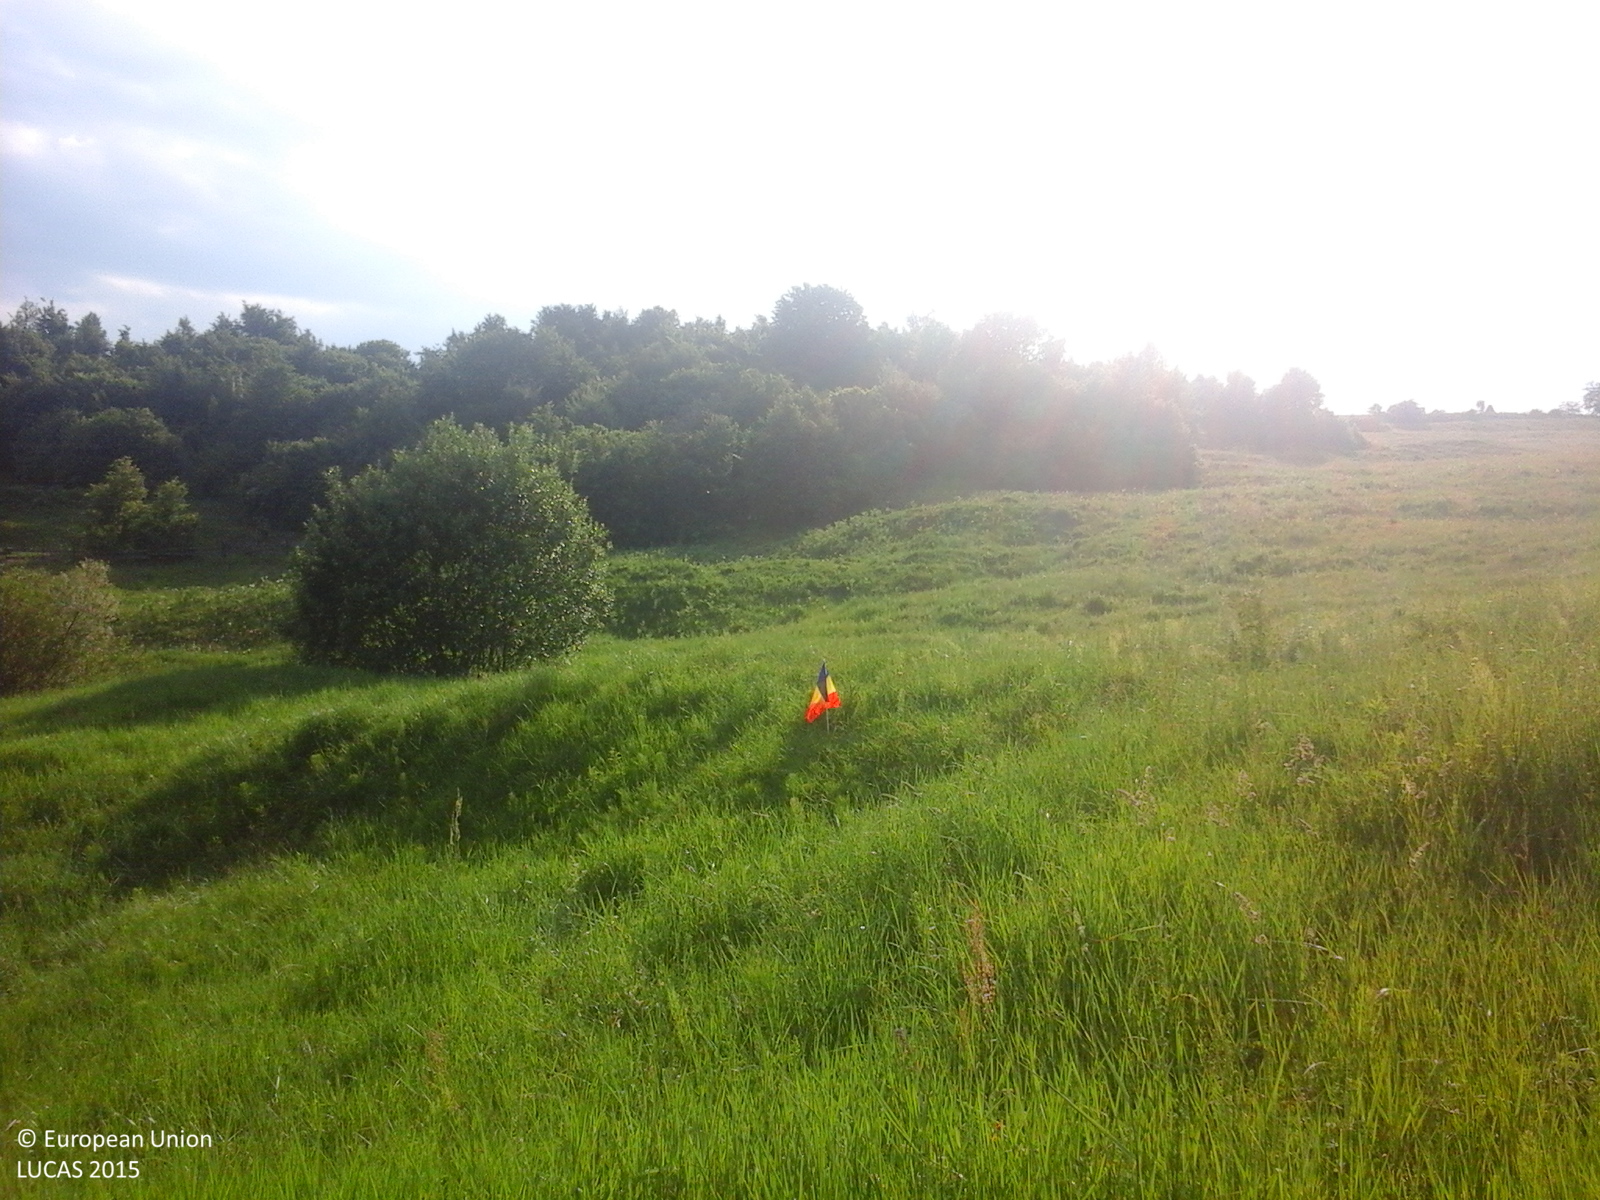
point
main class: Grassland
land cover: Grassland without tree/shrub cover
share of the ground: > 75 %
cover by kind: herbaceous plants 100 %
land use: Agriculture (excluding fallow land and kitchen gardens)
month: June
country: RO
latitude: 46.6996
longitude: 26.5771
